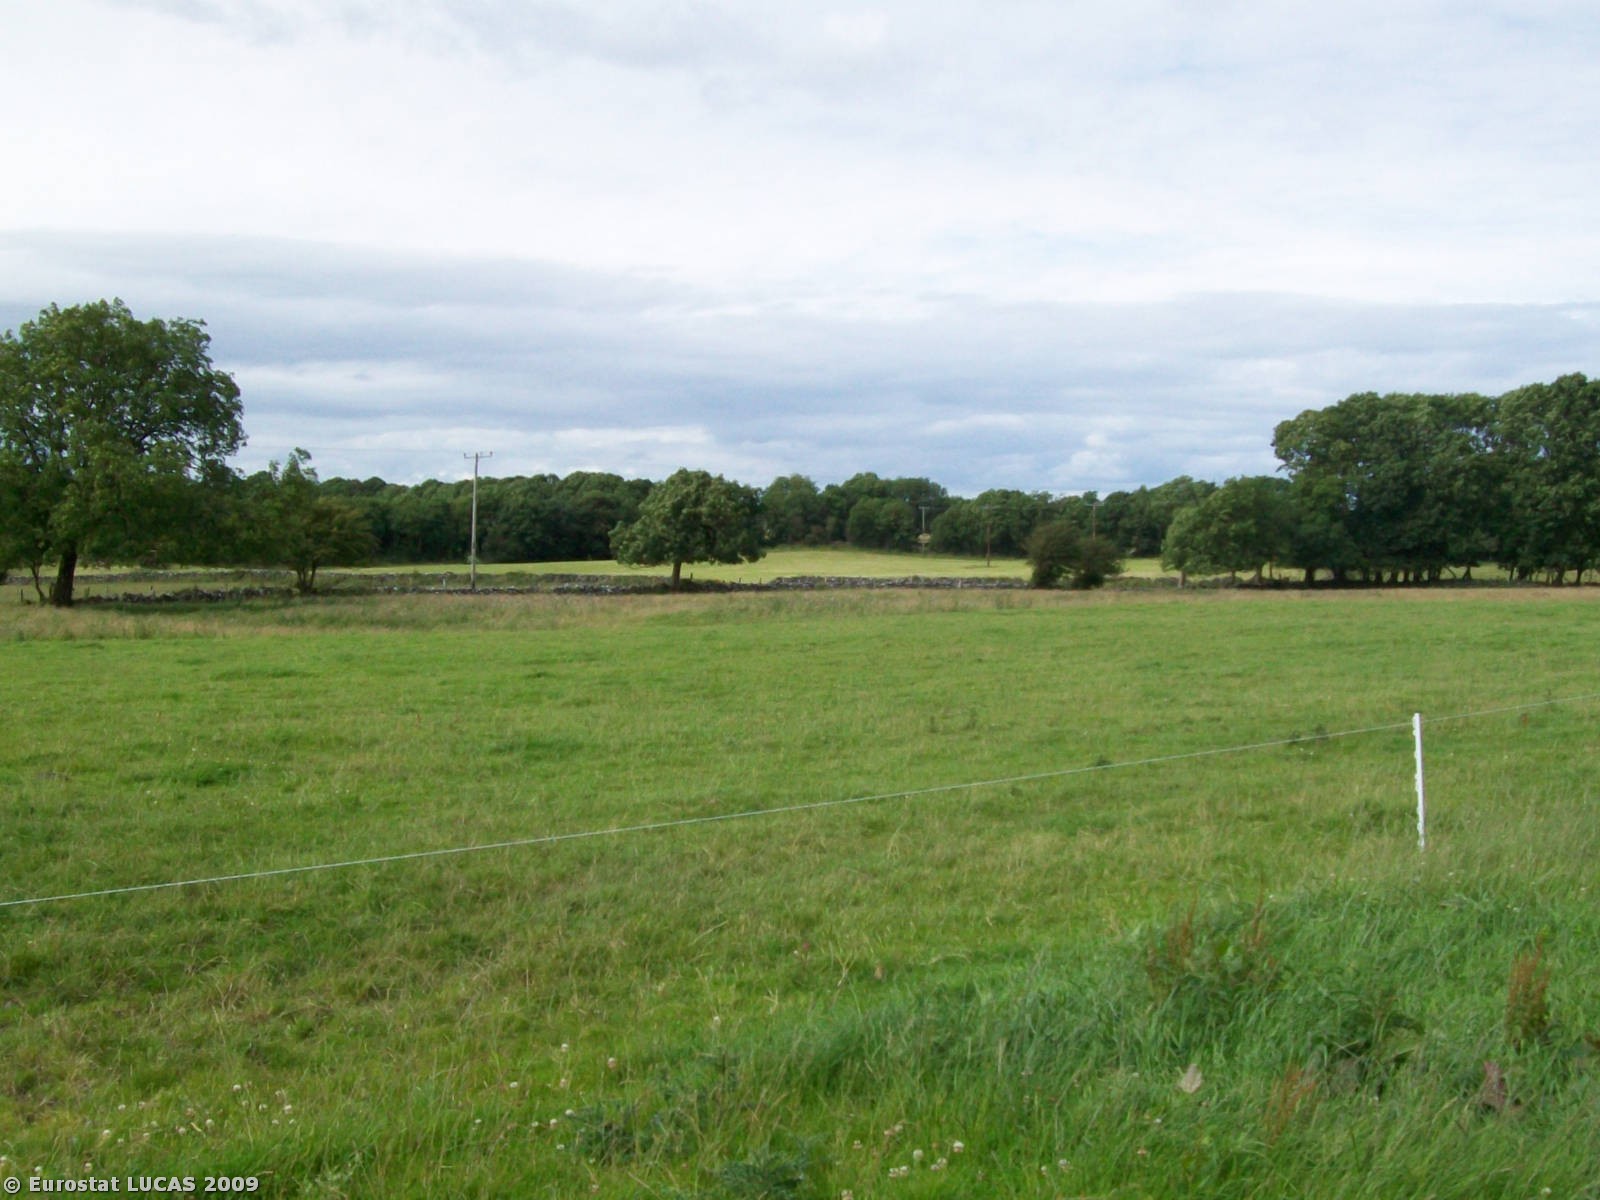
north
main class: Grassland
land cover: Grassland without tree/shrub cover
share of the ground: > 75 %
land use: Agriculture (excluding fallow land and kitchen gardens)
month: July
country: IE
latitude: 53.3147
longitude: -8.8023
